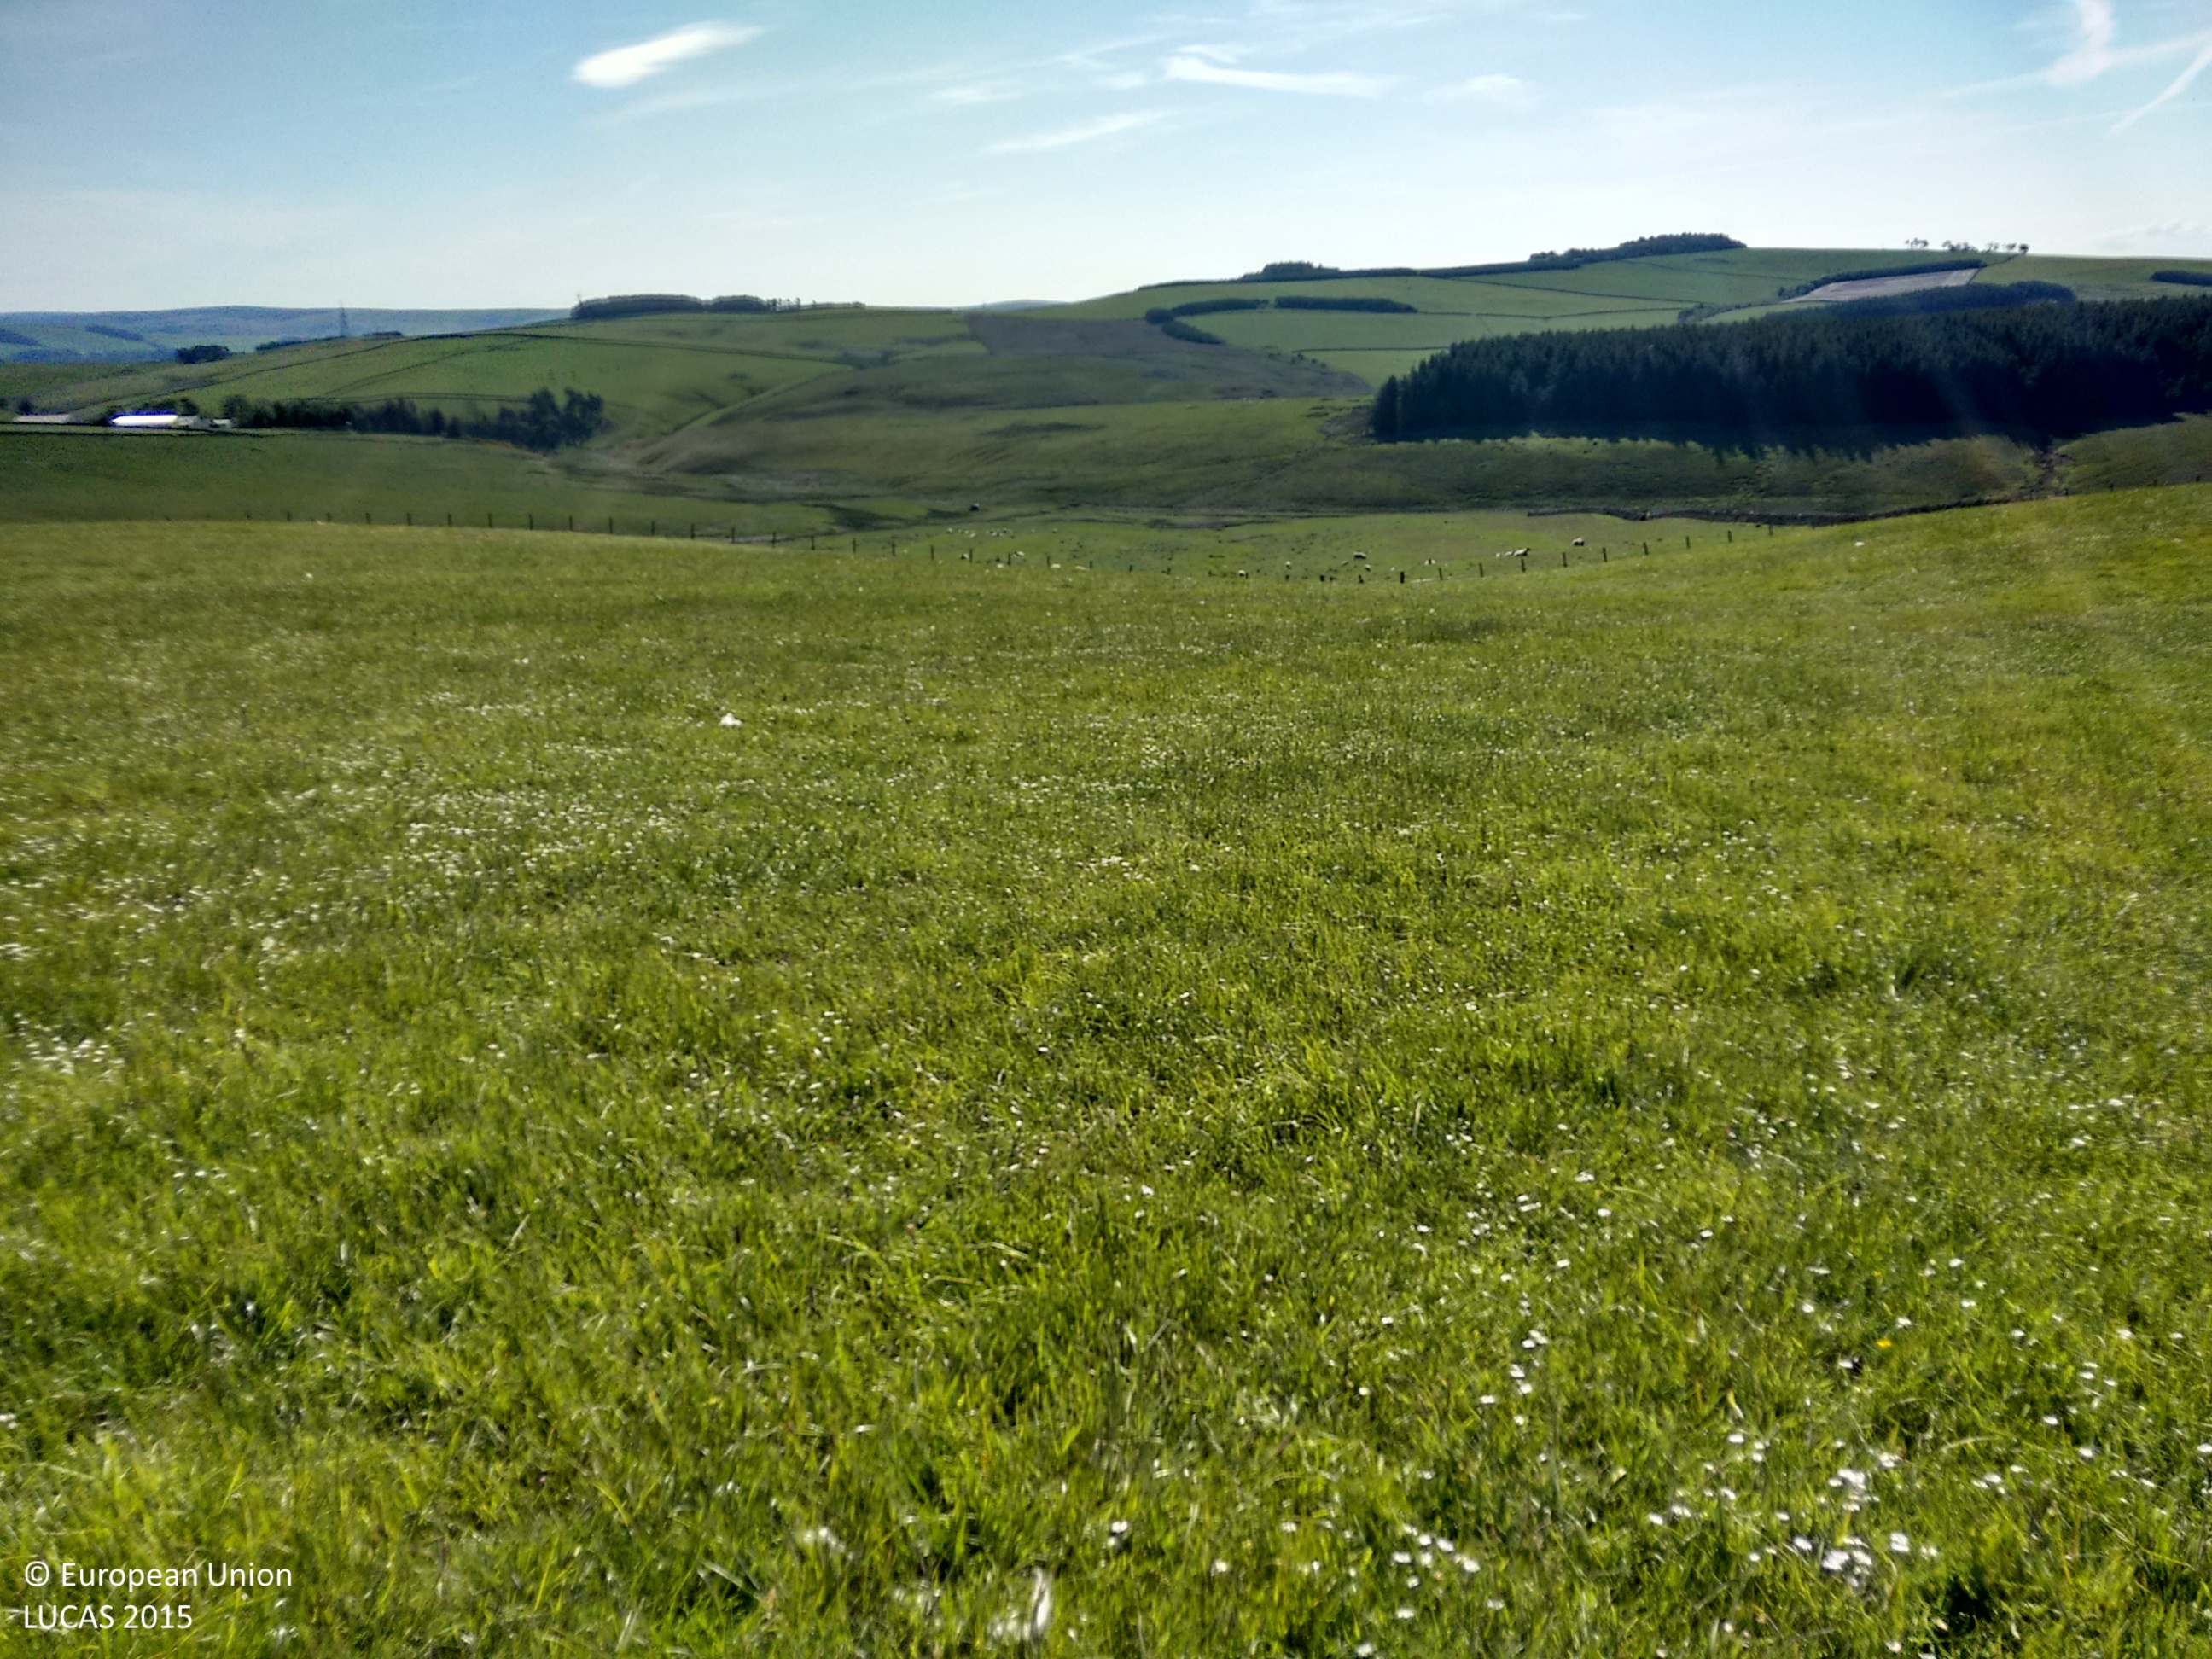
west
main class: Grassland
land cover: Grassland without tree/shrub cover
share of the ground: > 75 %
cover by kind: herbaceous plants 100 %
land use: Agriculture (excluding fallow land and kitchen gardens)
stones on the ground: < 10 %
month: June
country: GB
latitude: 55.7558
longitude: -2.8615
